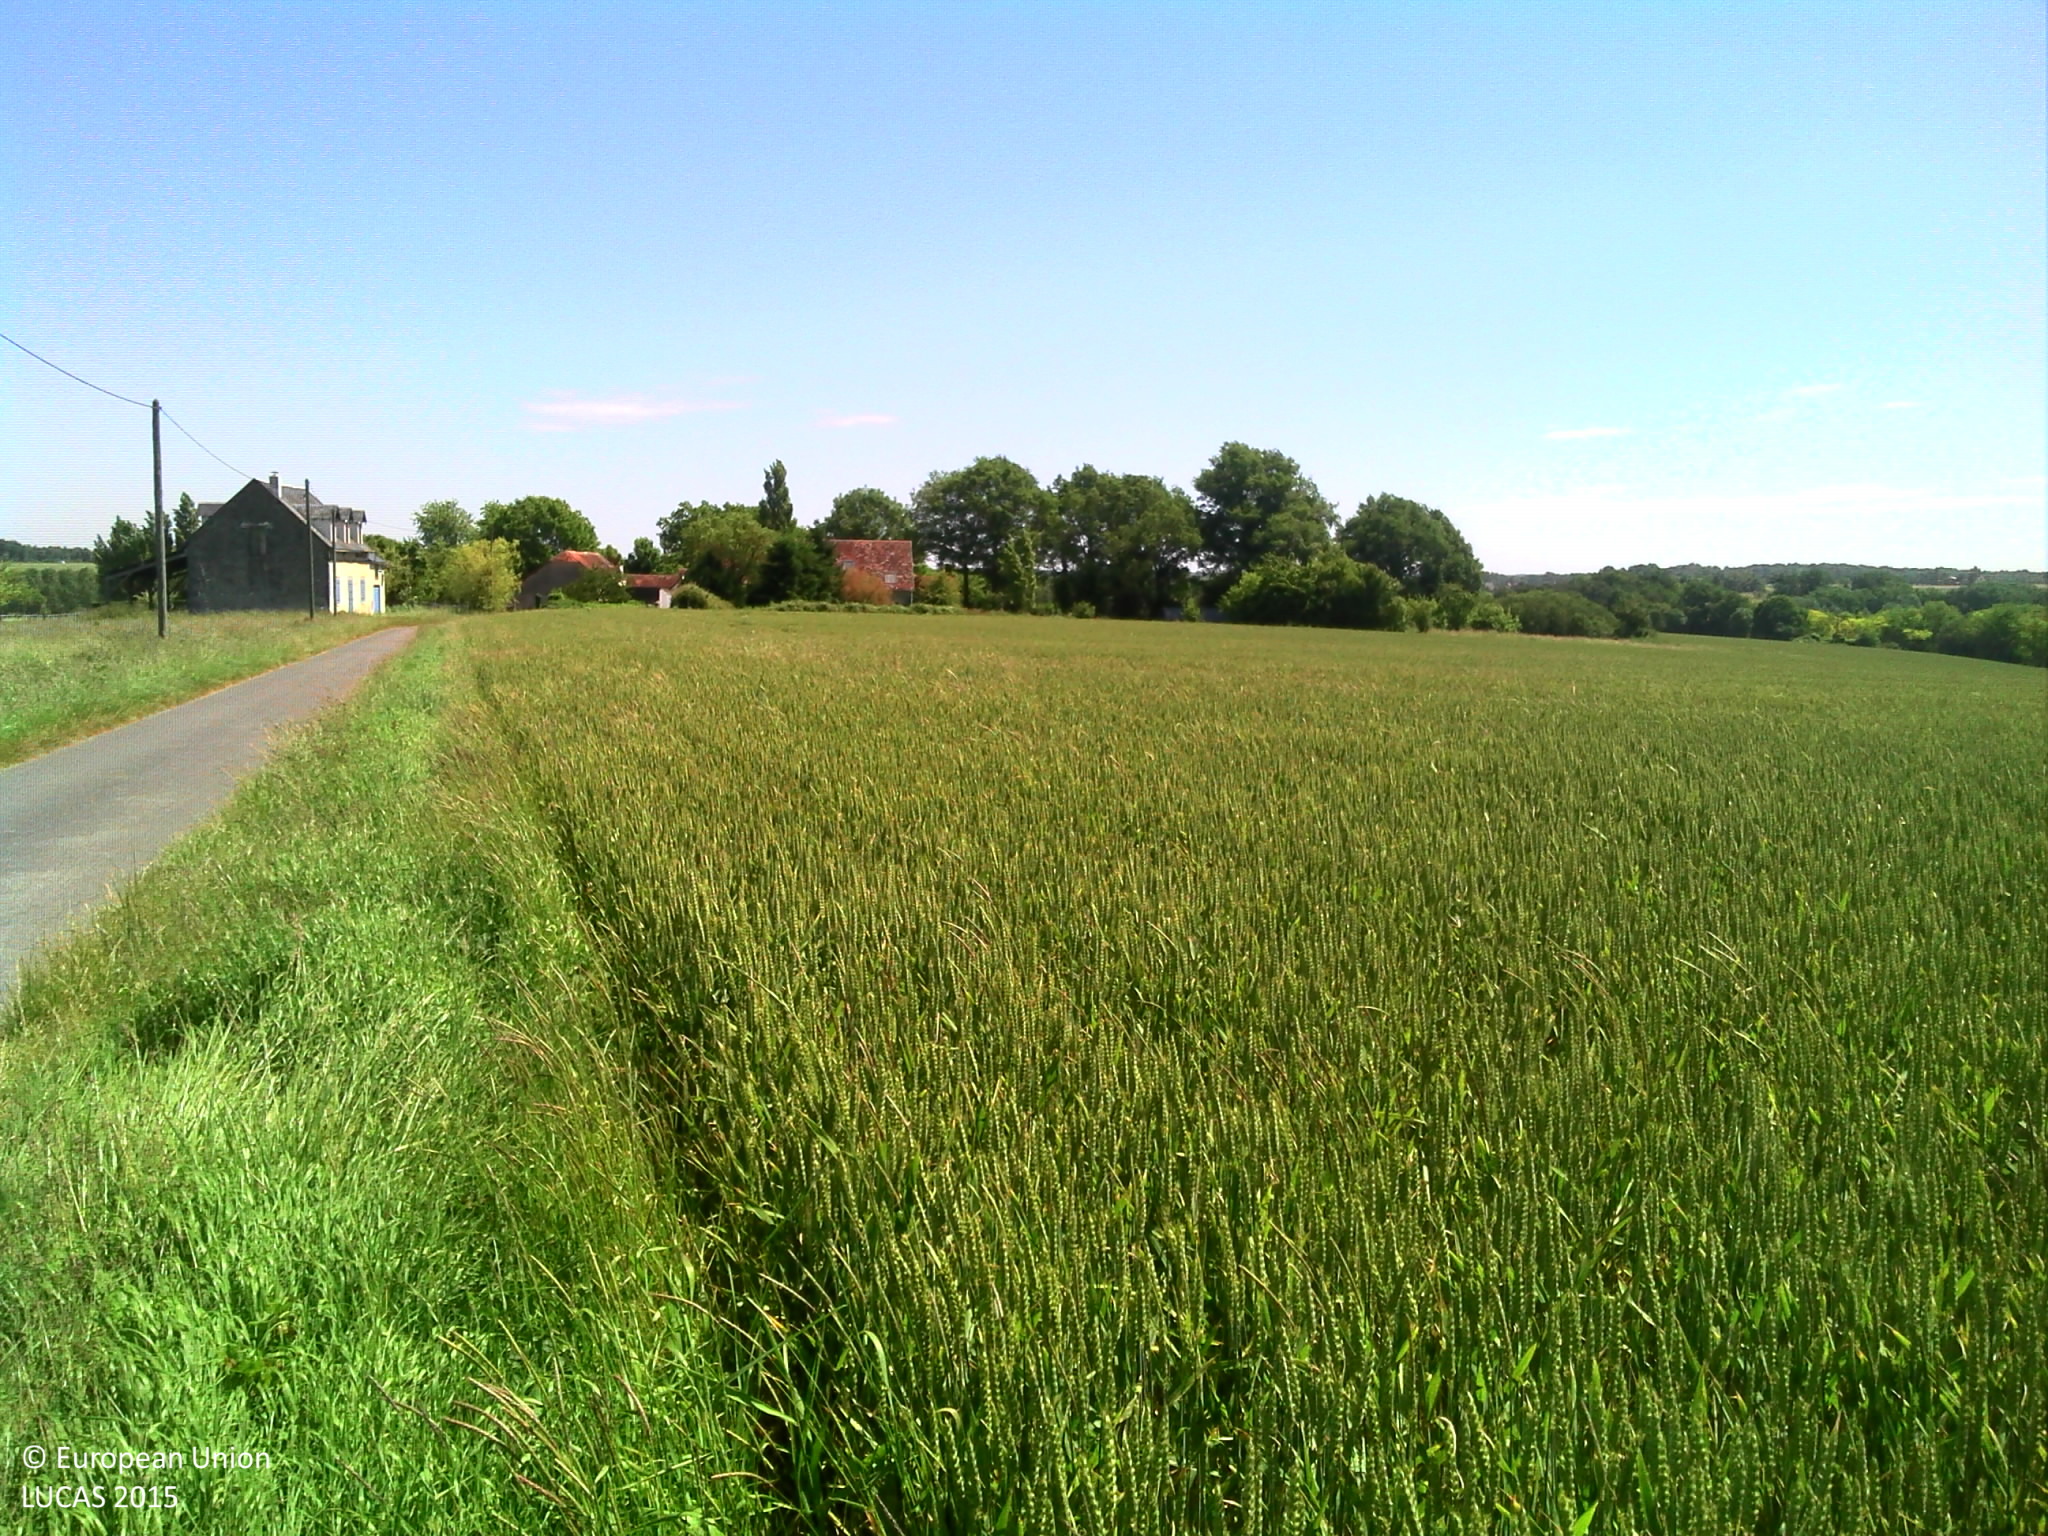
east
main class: Cropland
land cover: Common wheat
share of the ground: > 75 %
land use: Agriculture (excluding fallow land and kitchen gardens)
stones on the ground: < 10 %
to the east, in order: Common wheat; Durum wheat; Common wheat
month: June
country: FR
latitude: 47.1304
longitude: 1.2187
